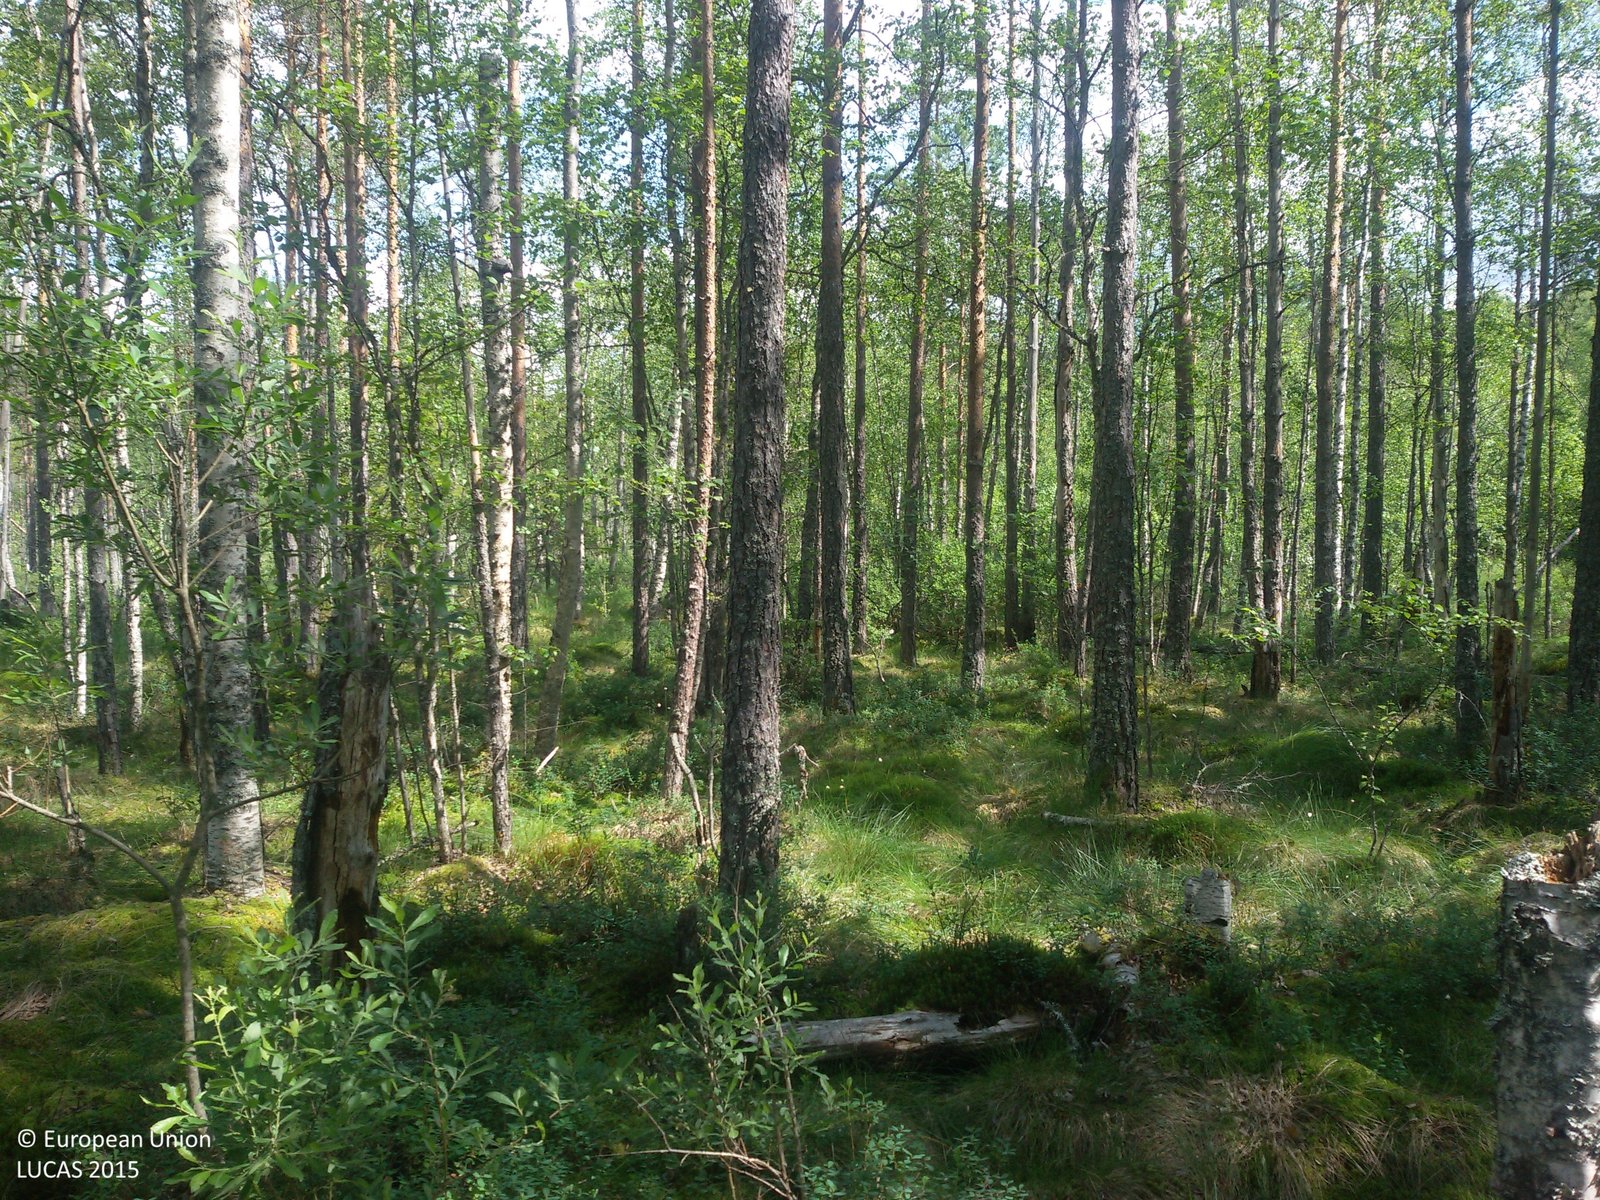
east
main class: Woodland
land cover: Broadleaved woodland
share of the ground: > 75 %
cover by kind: broadleaved forest trees 80 %, herbaceous plants 10 %, lichens and mosses 10 %
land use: Semi-natural and natural areas not in use
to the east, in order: Broadleaved woodland; Inland marshes; Spruce dominated mixed woodland; Spruce dominated coniferous woodland; Spruce dominated mixed woodland; Broadleaved woodland
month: July
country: SE
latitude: 60.5239
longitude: 15.0343
